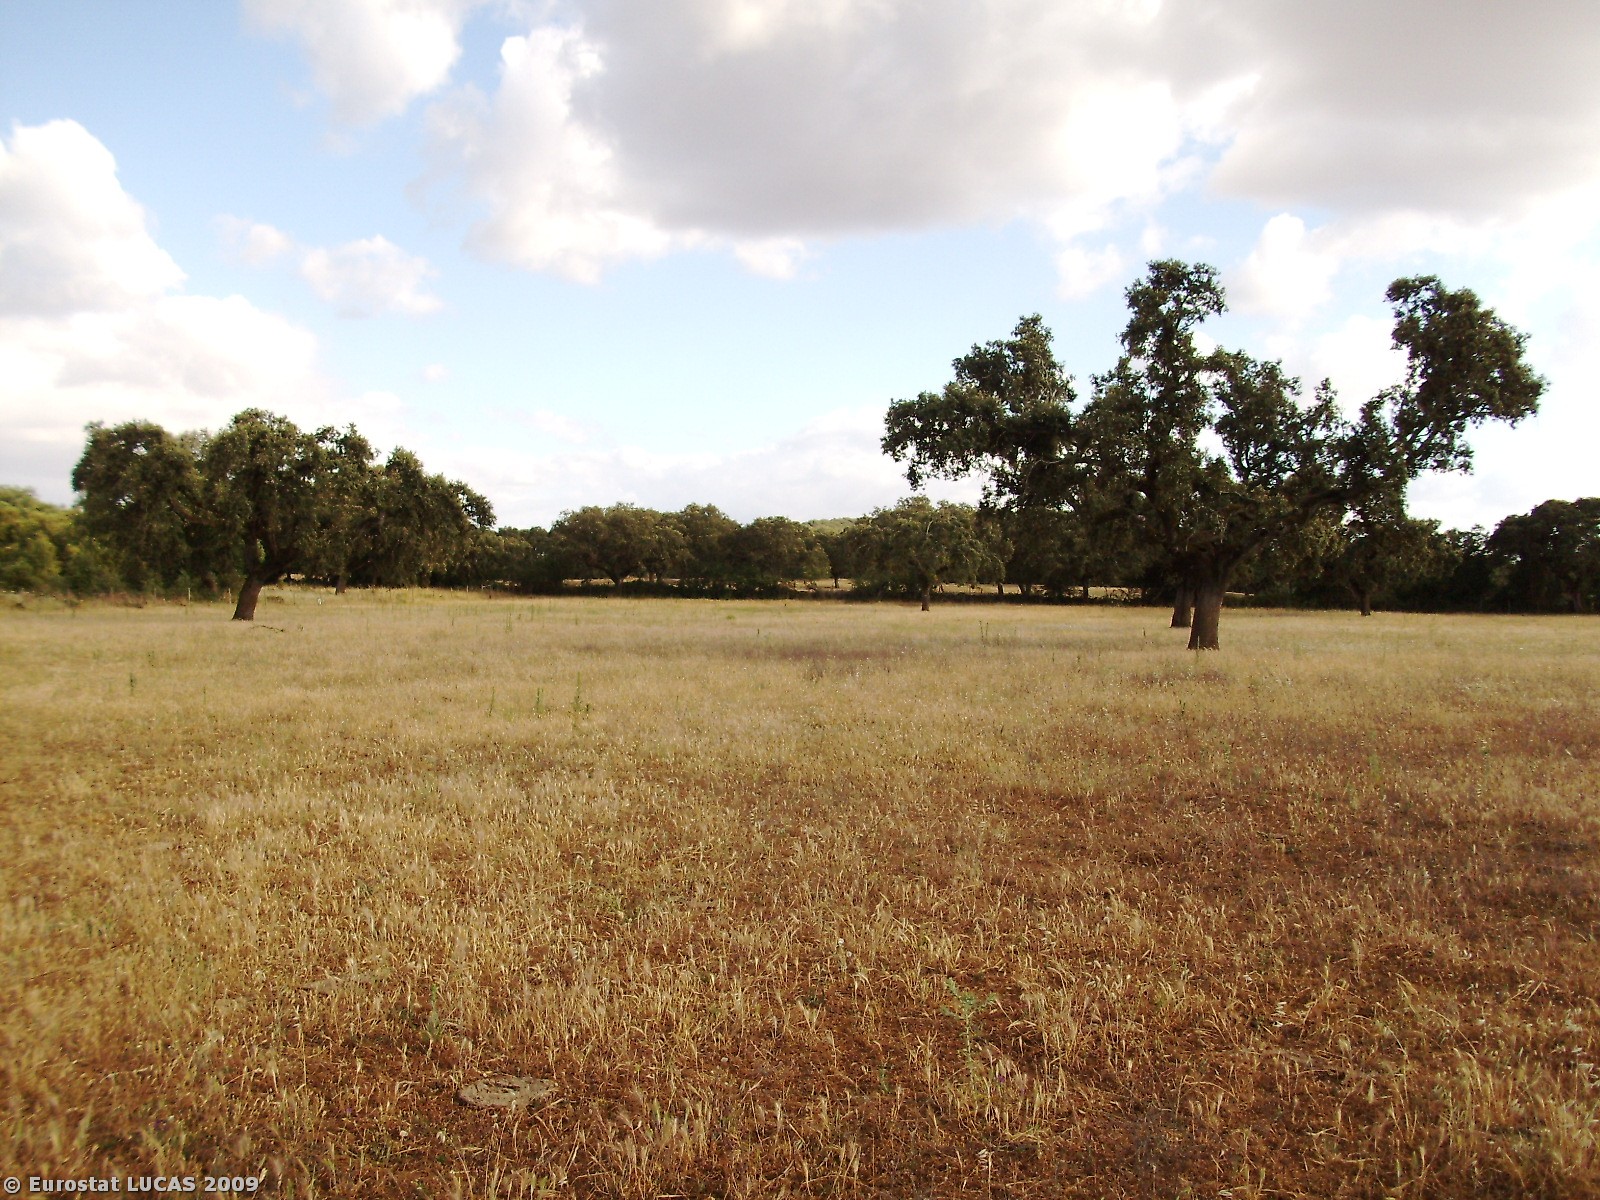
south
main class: Grassland
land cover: Grassland with sparse tree/shrub cover
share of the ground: > 75 %
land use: Agriculture (excluding fallow land and kitchen gardens)
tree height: > 5 m
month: June
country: PT
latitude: 38.9288
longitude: -7.2528
